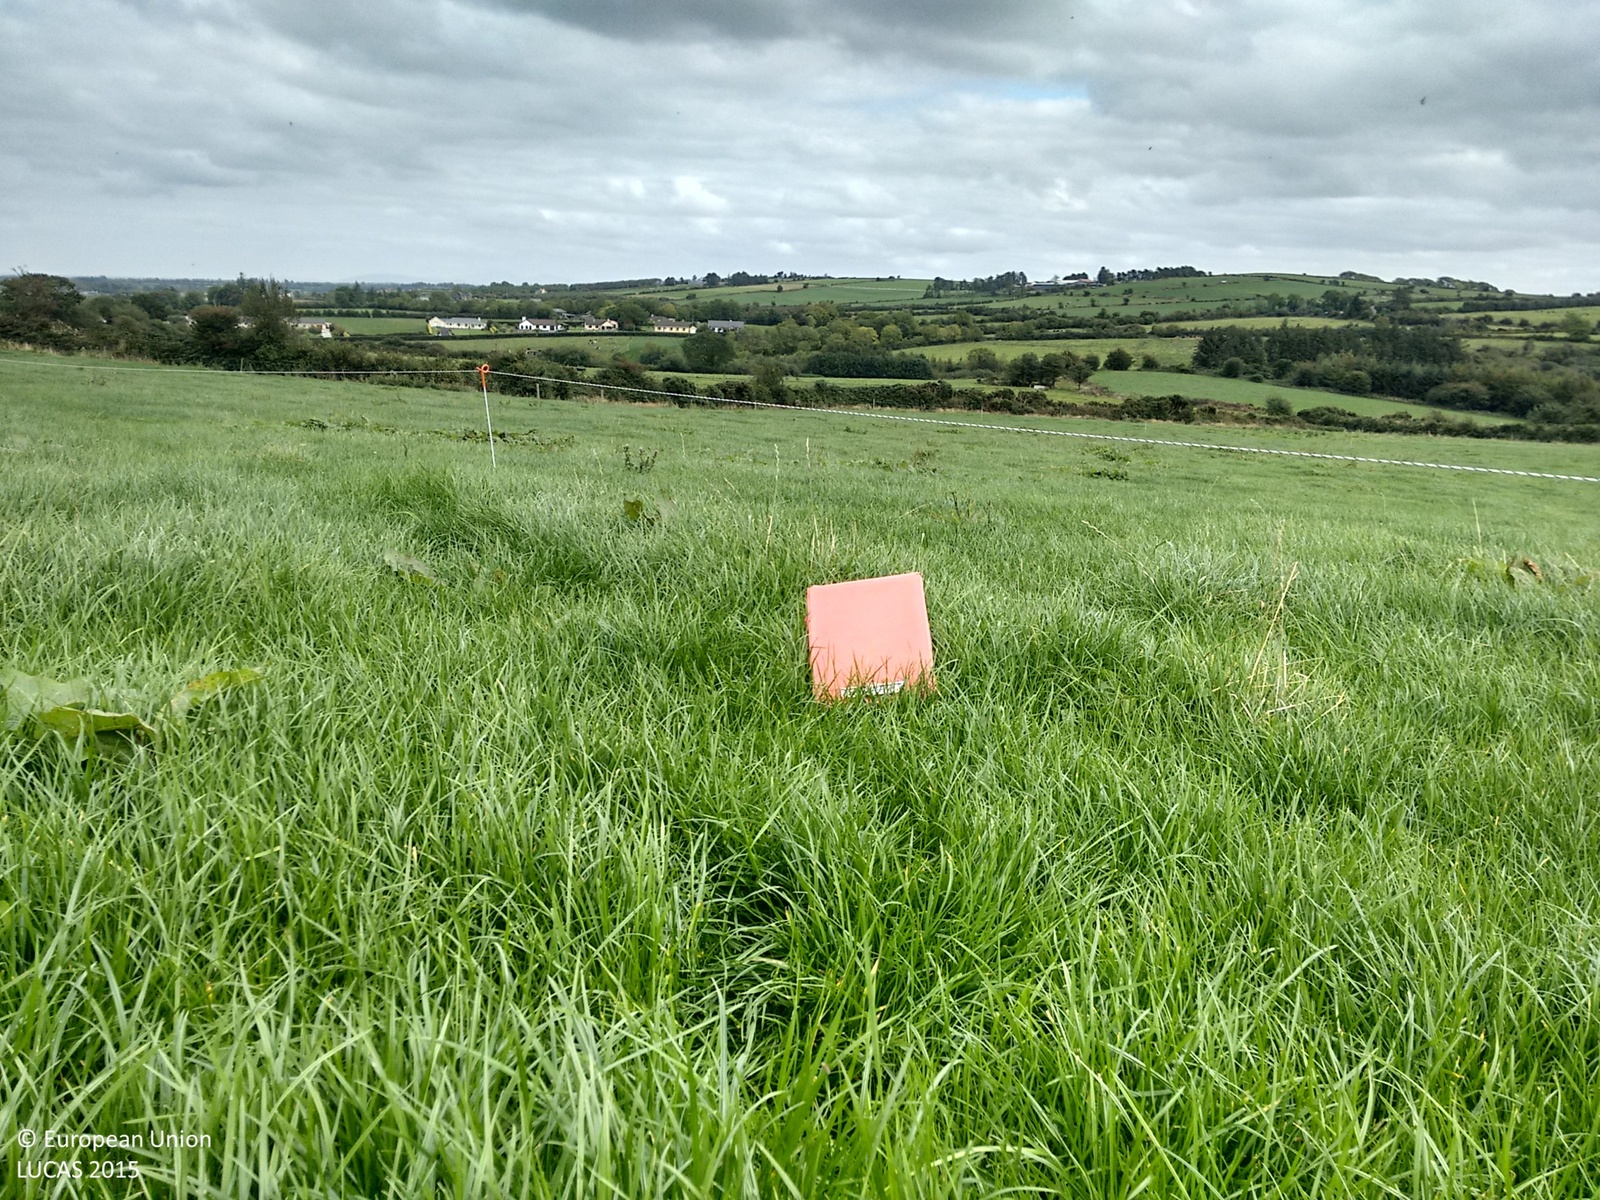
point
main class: Grassland
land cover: Grassland without tree/shrub cover
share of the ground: > 75 %
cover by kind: herbaceous plants 100 %
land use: Agriculture (excluding fallow land and kitchen gardens)
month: September
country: IE
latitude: 52.3332
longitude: -8.9209
